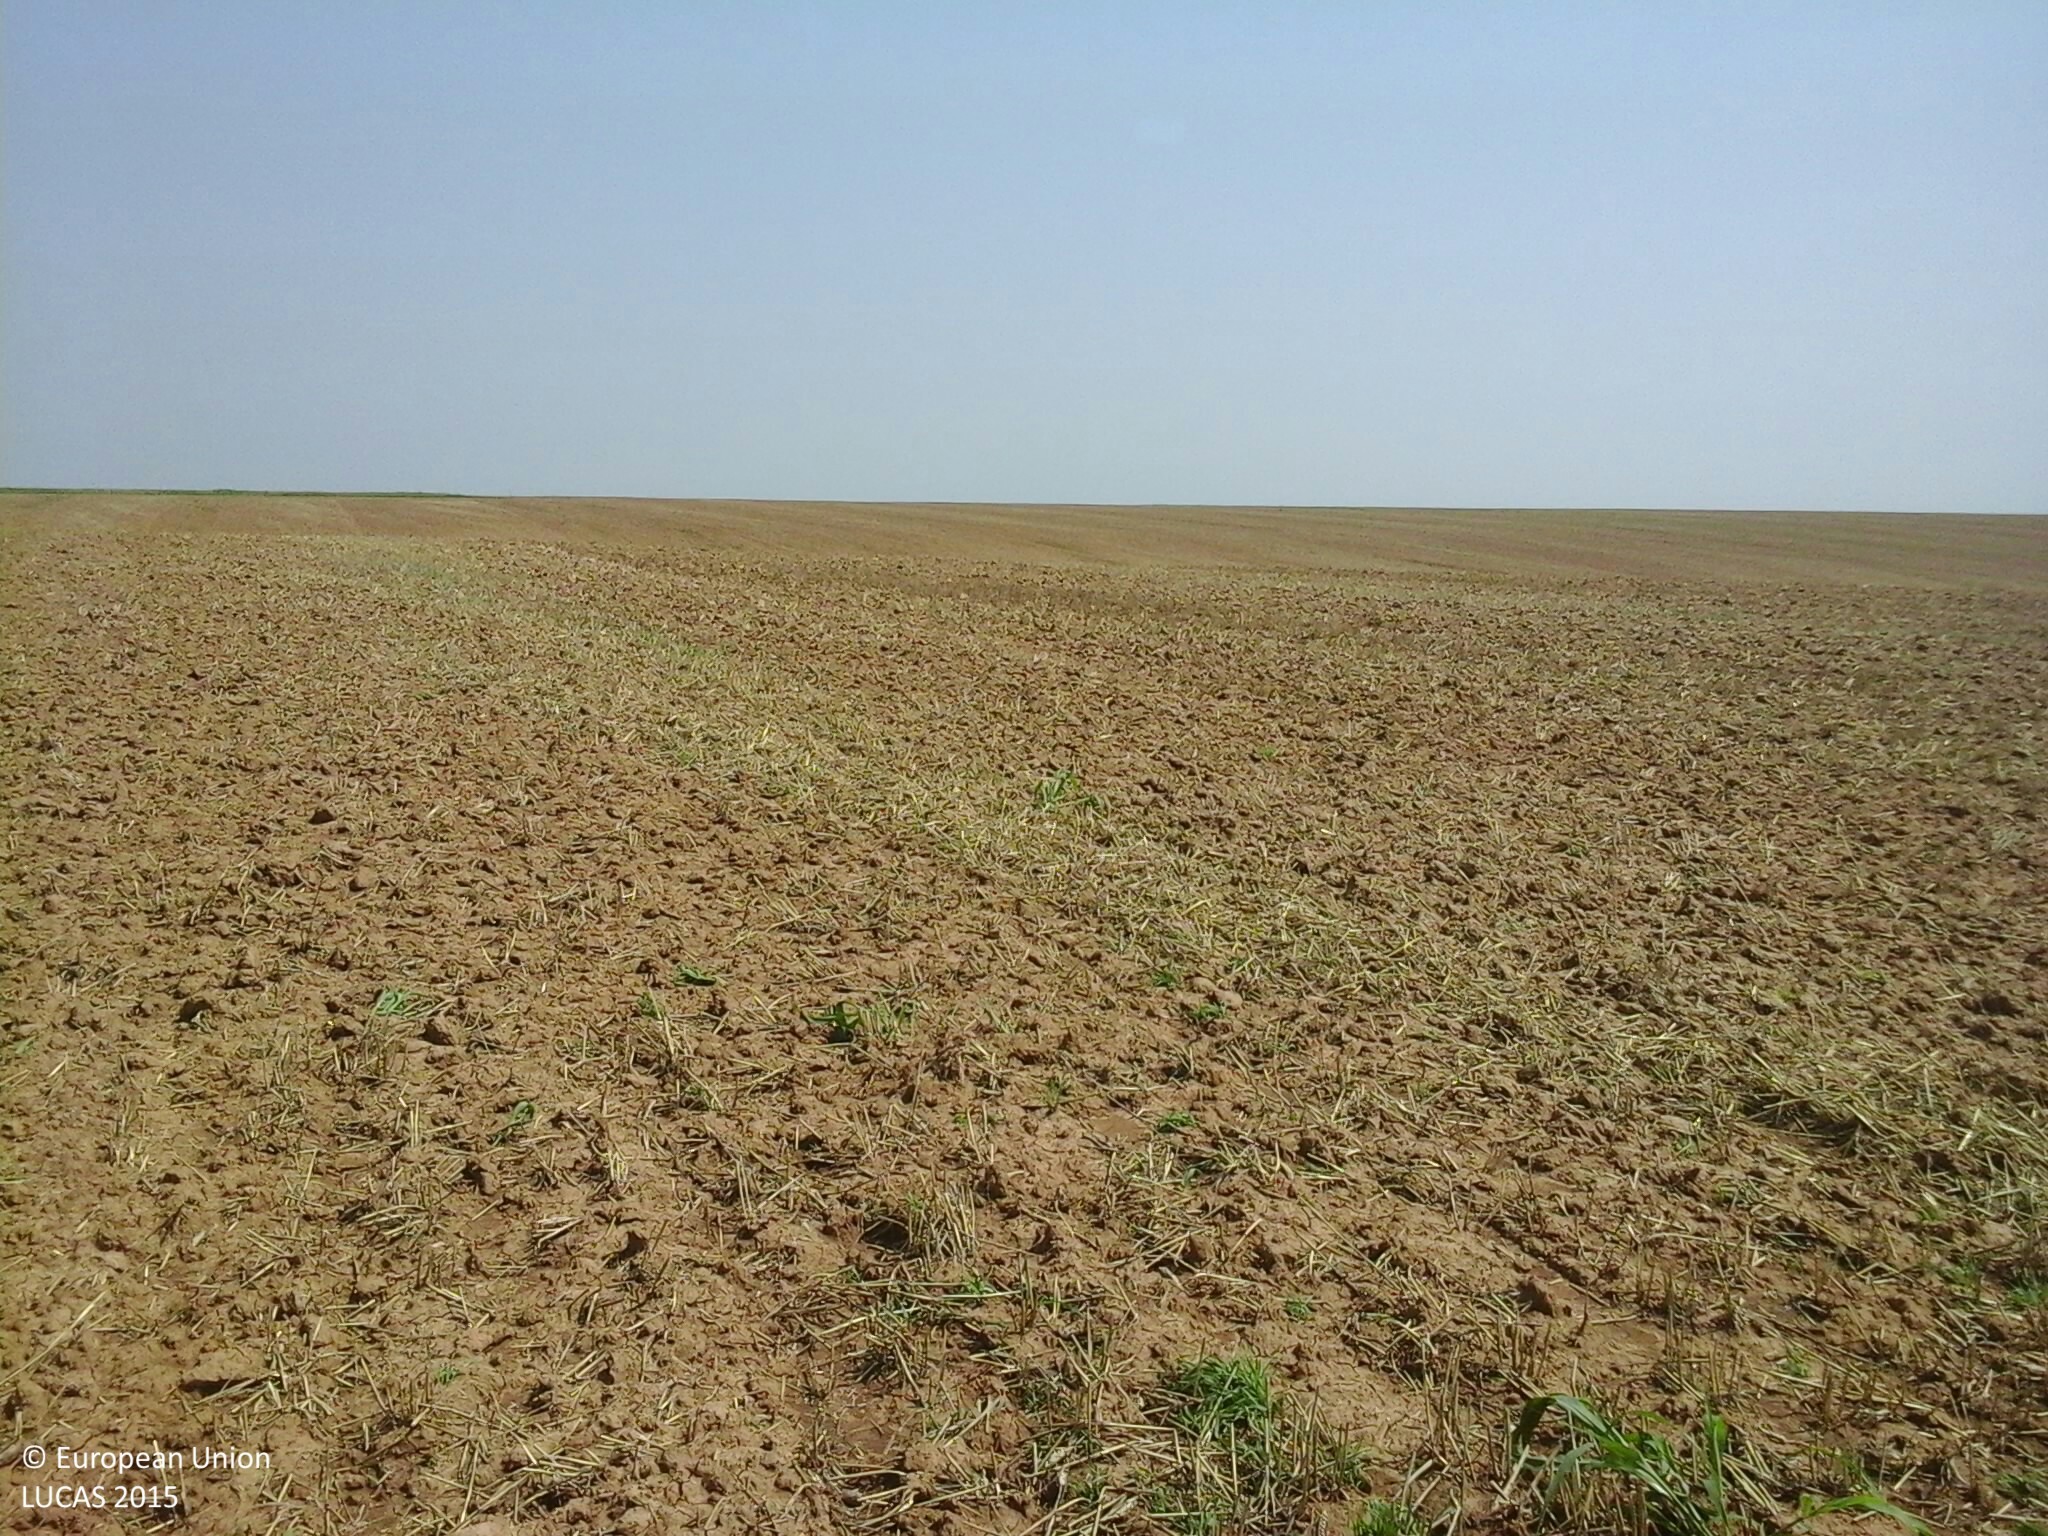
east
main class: Cropland
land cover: Common wheat
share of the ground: < 10 %
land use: Agriculture (excluding fallow land and kitchen gardens)
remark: Harvested field
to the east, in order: Common wheat
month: August
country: HU
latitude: 45.9873
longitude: 18.3600
